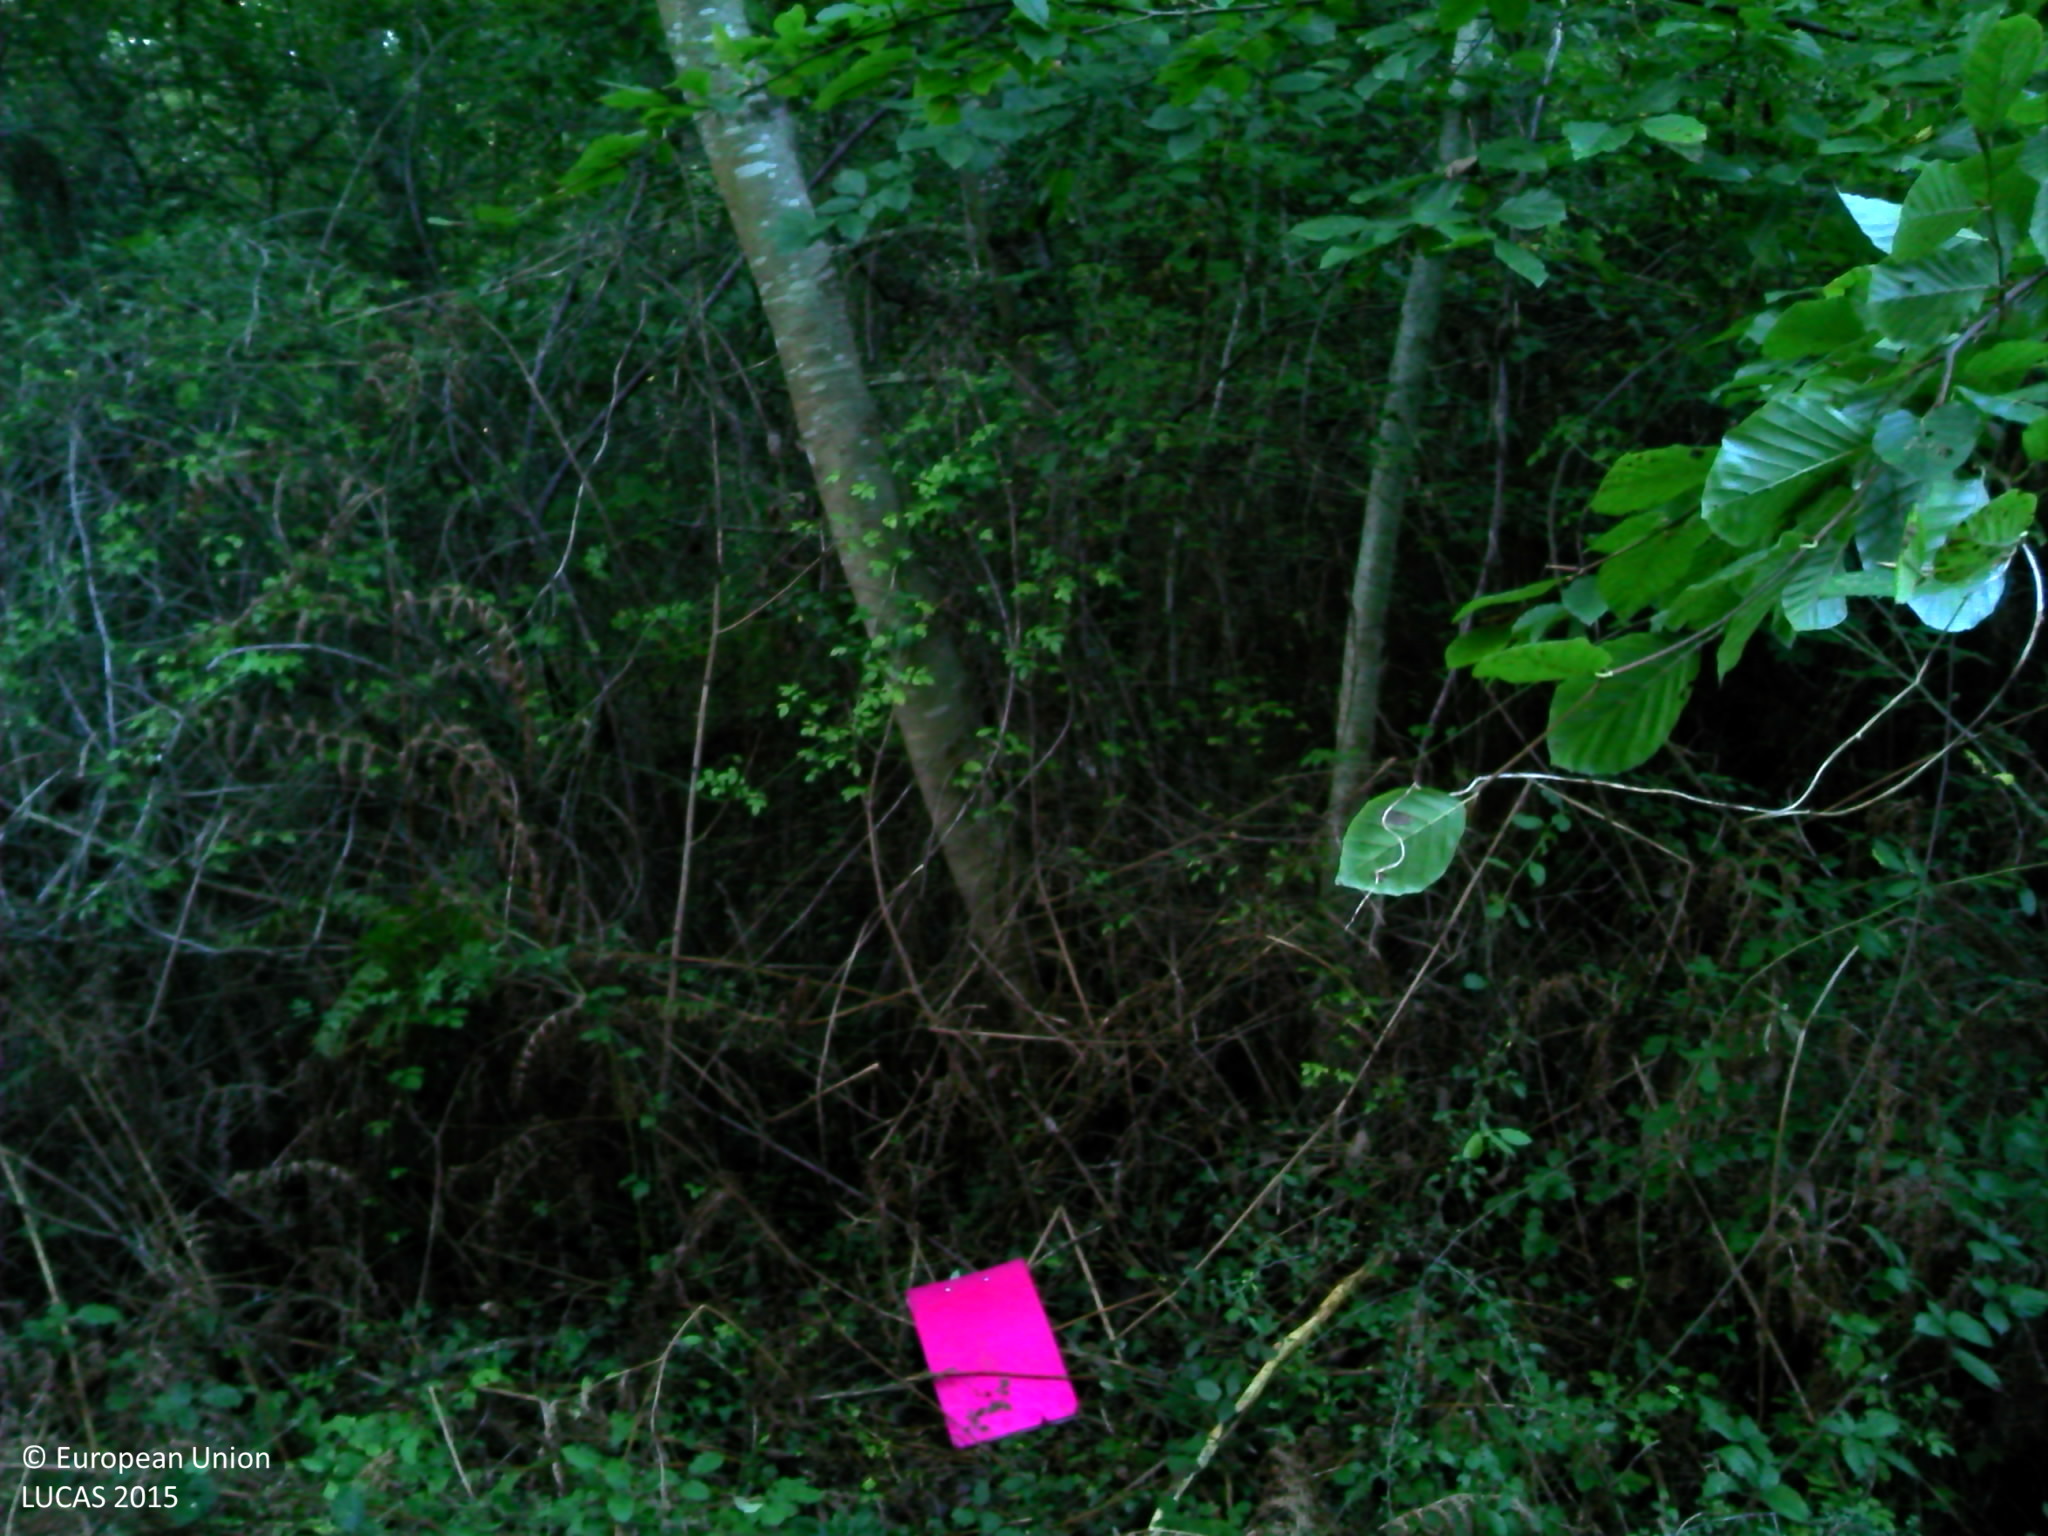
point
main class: Woodland
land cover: Broadleaved woodland
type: beech forest
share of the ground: > 75 %
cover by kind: broadleaved forest trees 80 %, shrubs 10 %, herbaceous plants 10 %
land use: Forestry
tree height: > 5 m
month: September
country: FR
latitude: 43.1775
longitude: -0.6992
